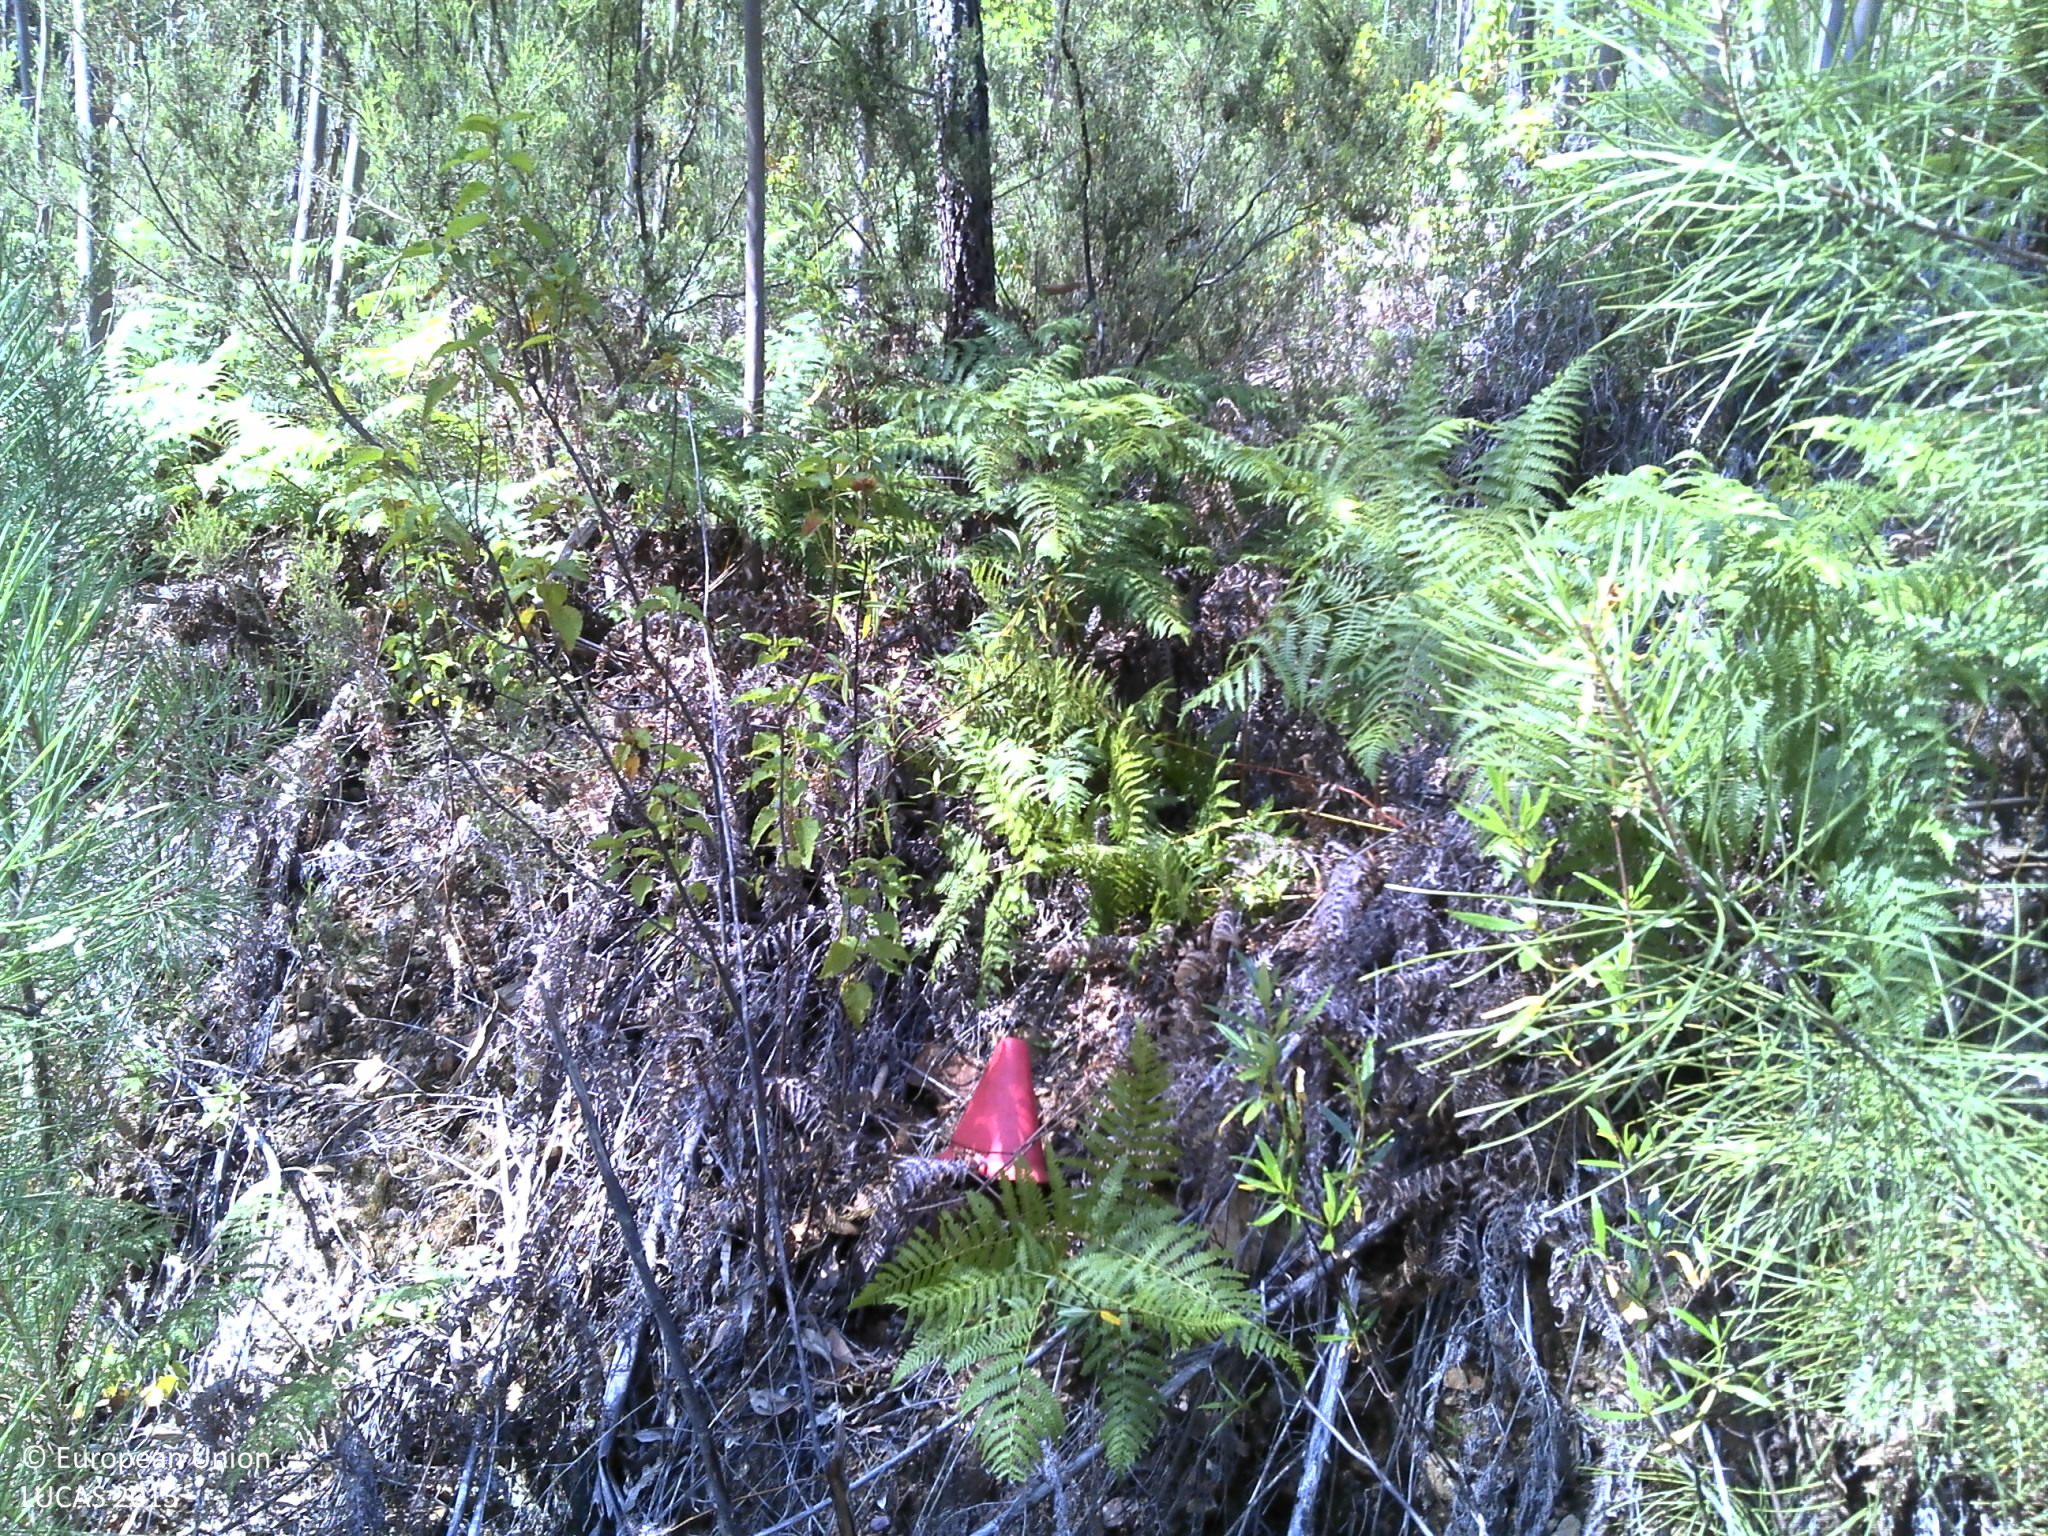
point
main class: Woodland
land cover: Broadleaved woodland
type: exotic forest
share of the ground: 10 - 25 %
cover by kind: shrubs 60 %, broadleaved forest trees 20 %, unconsolidated bare surface 20 %
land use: Forestry
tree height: > 5 m
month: June
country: PT
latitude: 39.9831
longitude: -8.0445
